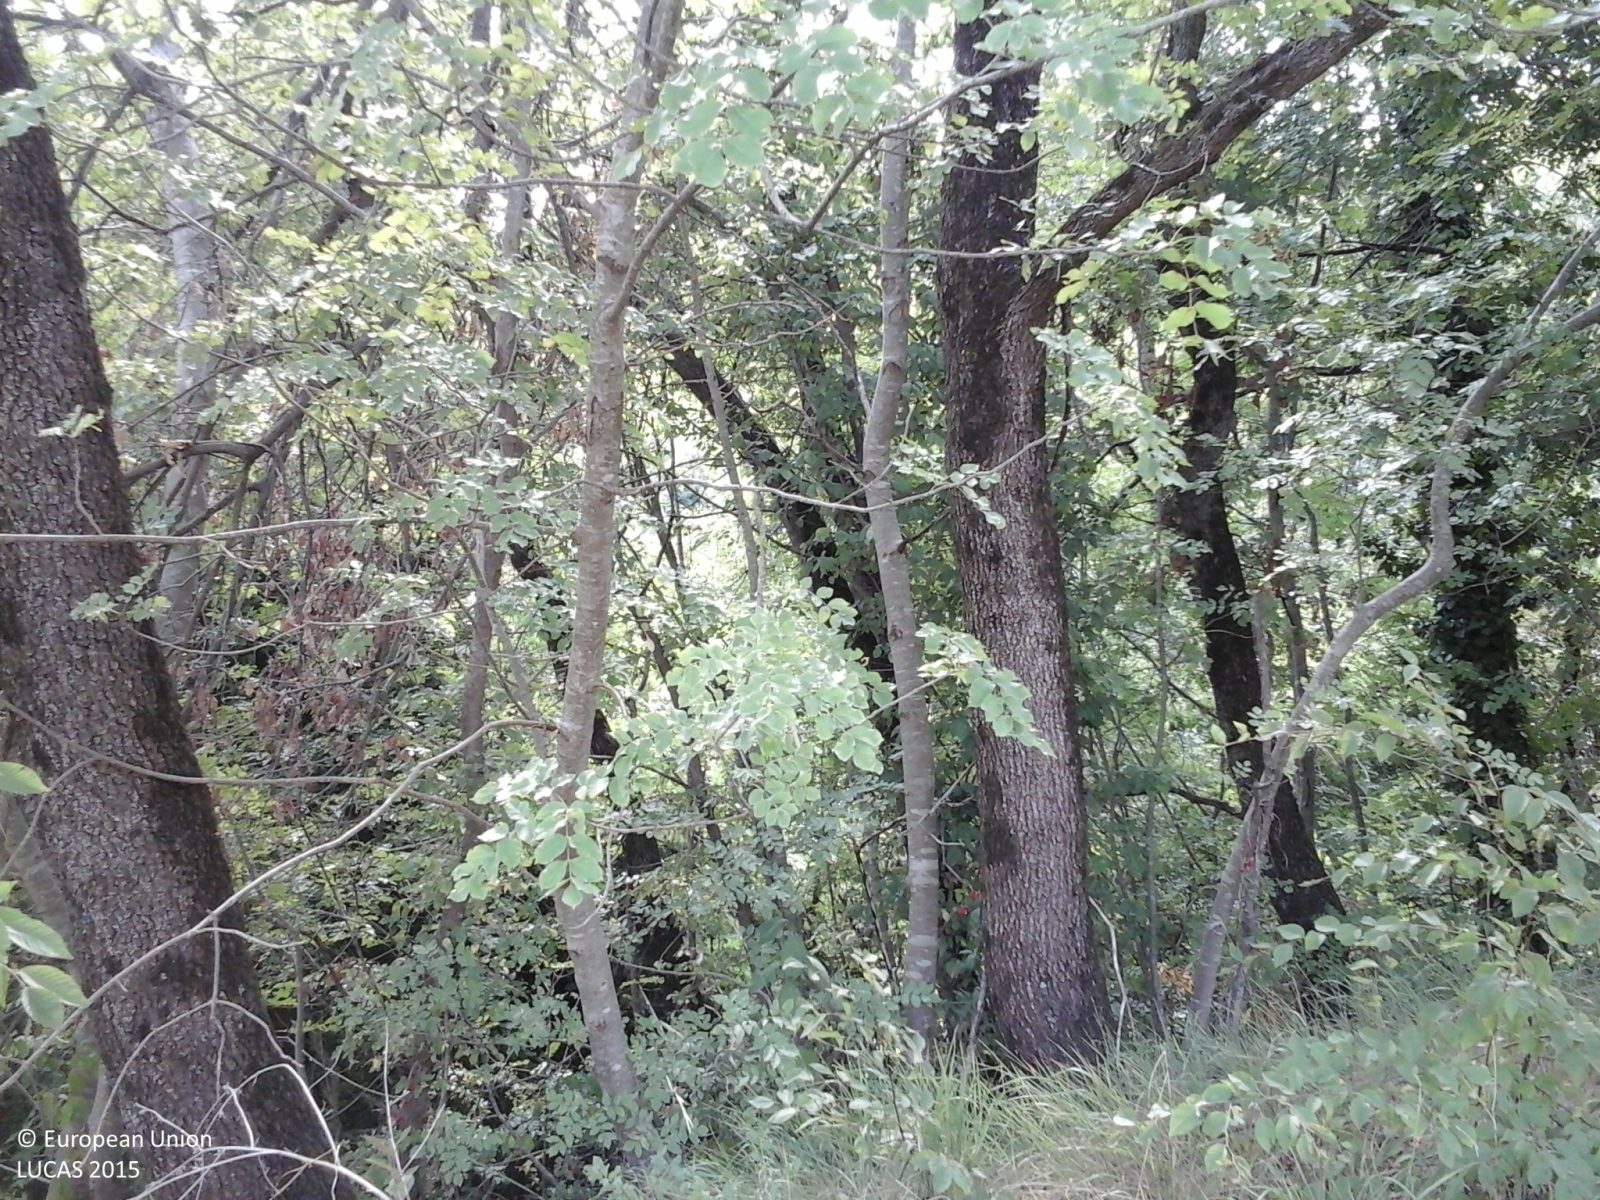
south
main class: Woodland
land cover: Broadleaved woodland
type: thermophilous deciduous forest
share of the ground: > 75 %
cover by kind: broadleaved forest trees 80 %, shrubs 10 %, herbaceous plants 10 %
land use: Semi-natural and natural areas not in use
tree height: > 5 m
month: September
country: IT
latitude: 42.5105
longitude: 13.7979
